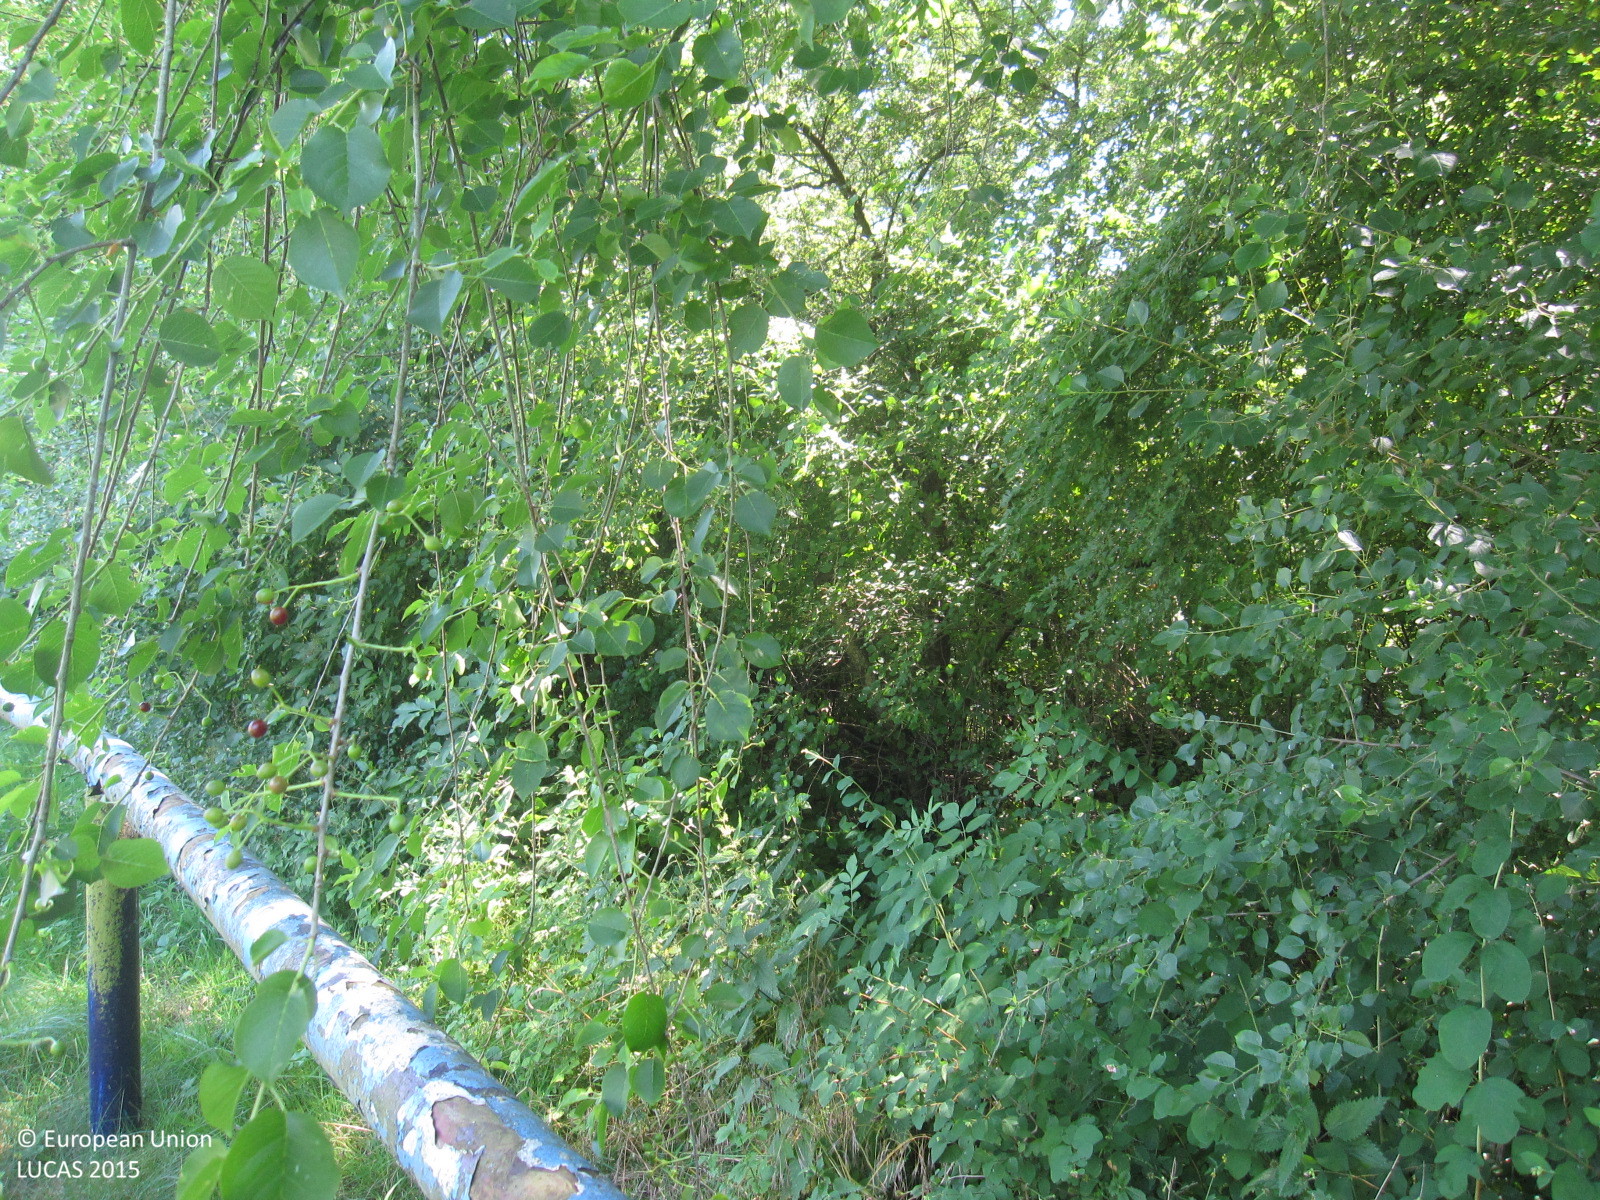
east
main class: Woodland
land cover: Broadleaved woodland
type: mesophytic deciduous forest
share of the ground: > 75 %
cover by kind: broadleaved forest trees 75 %, shrubs 15 %, herbaceous plants 10 %
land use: Sport
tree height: > 5 m
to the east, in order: Broadleaved woodland; Ditches and canals; Broadleaved woodland; Dry pulses; Electric lines; Dry pulses; Tracks; Grass margins; Dry pulses; Lines of trees; Tracks; Grass margins; Ditches and canals; Grass margins; Paved roads, cycling and walking lanes; Grassland without tree/shrub cover; Ditches and canals; Grassland without tree/shrub cover; Broadleaved woodland; Grassland without tree/shrub cover
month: July
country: DE
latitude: 51.1187
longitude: 12.0712
